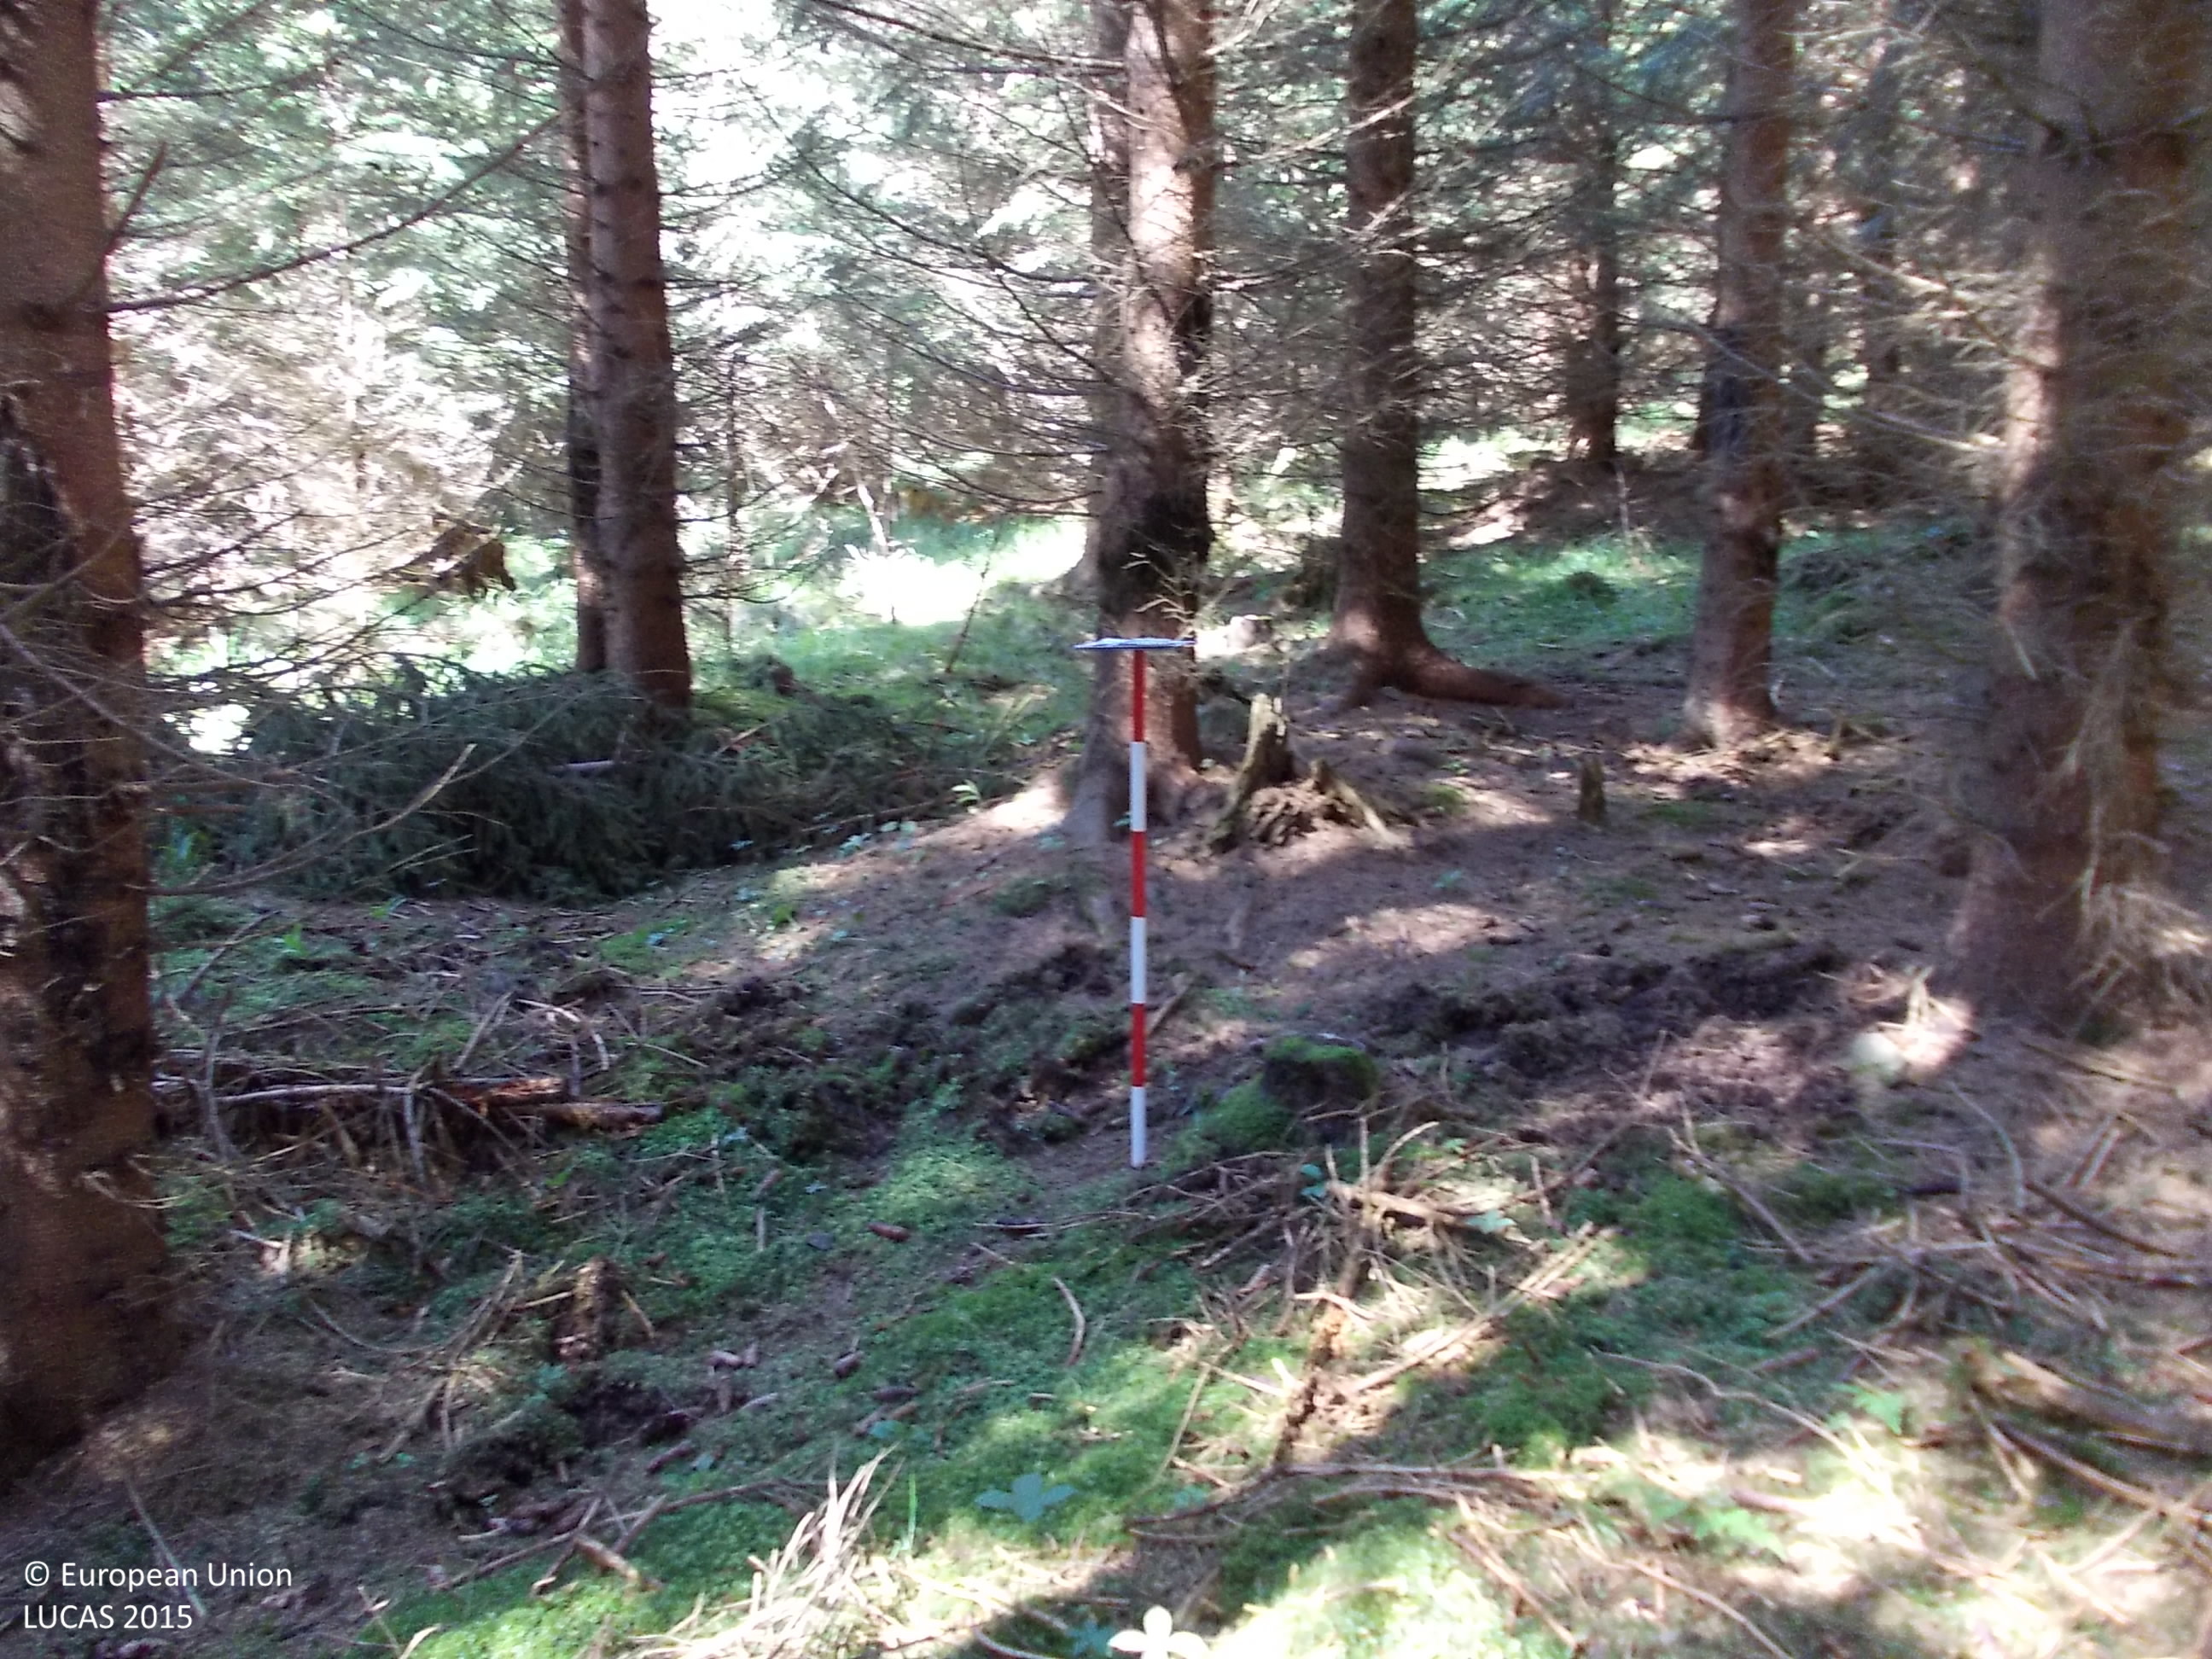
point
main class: Woodland
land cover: Spruce dominated coniferous woodland
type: hemiboreal forest and nemoral coniferous forest and mixed broadleaved-coniferous forest
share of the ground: > 75 %
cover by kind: coniferous forest trees 90 %, lichens and mosses 5 %, consolidated bare surface 5 %
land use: Forestry
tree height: > 5 m
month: June
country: CZ
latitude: 48.9719
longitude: 13.7022
